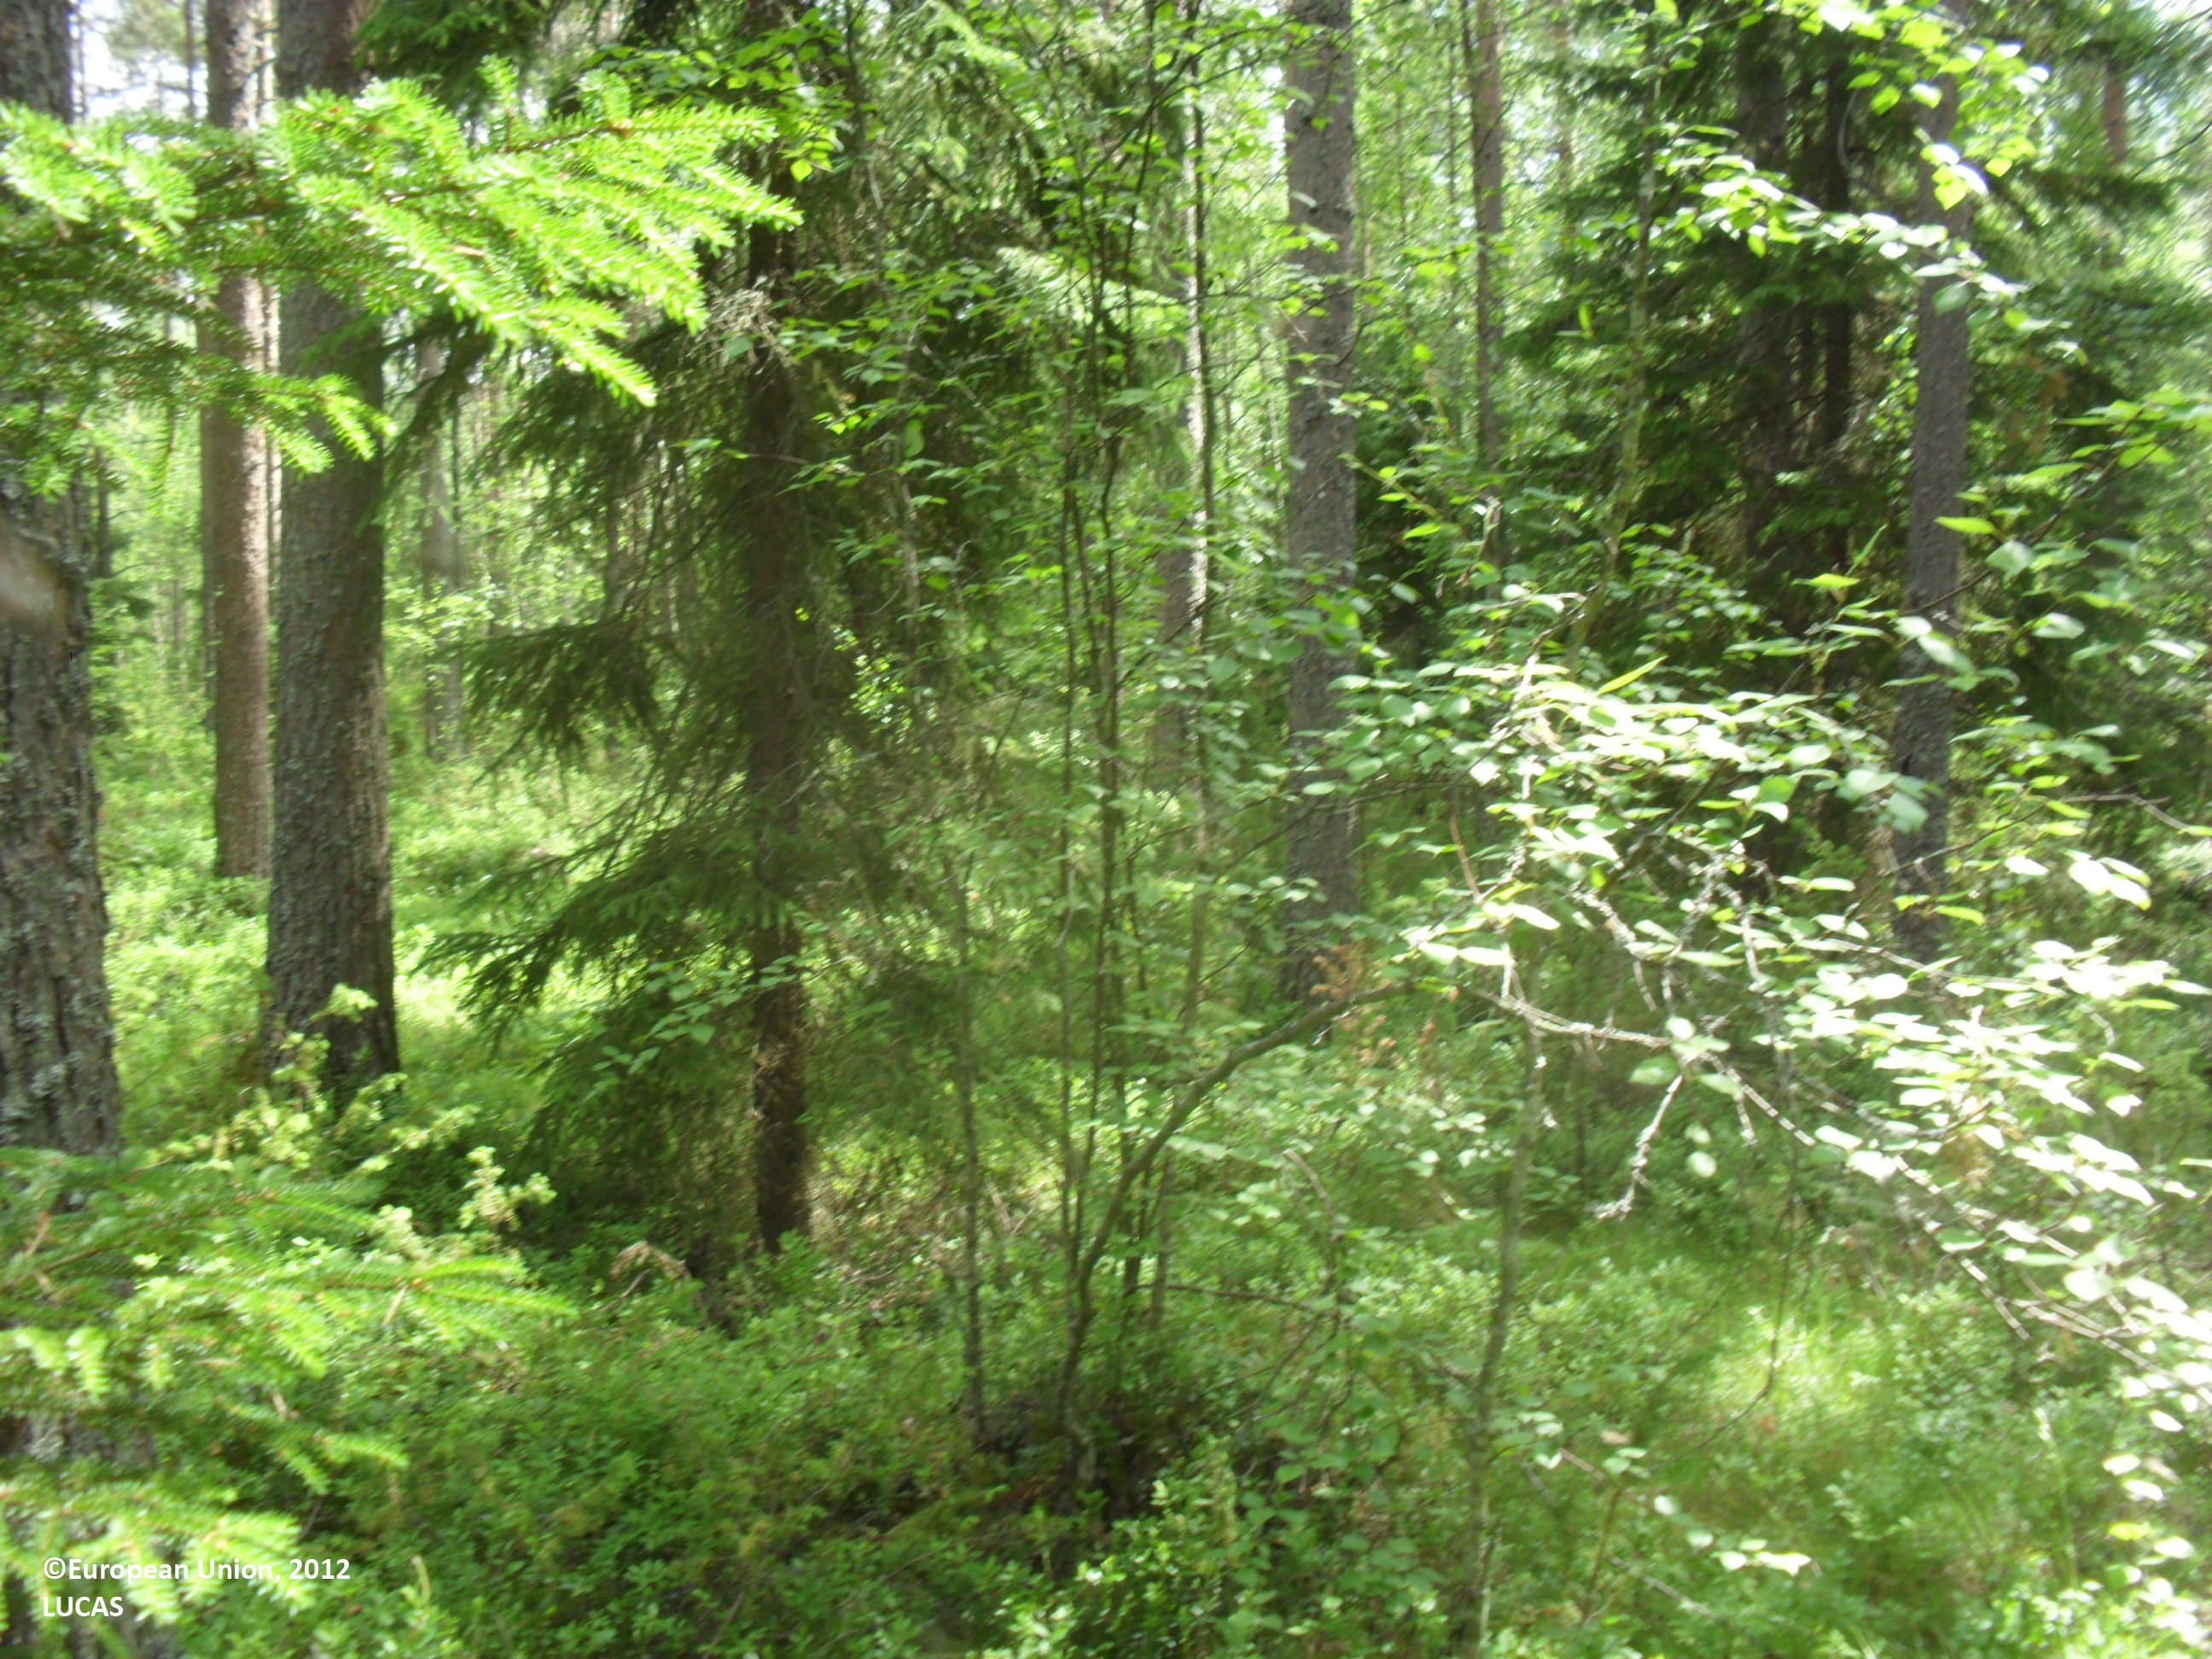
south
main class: Woodland
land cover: Other mixed woodland
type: boreal forest
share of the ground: 50 - 75 %
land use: Forestry
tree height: > 5 m
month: July
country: FI
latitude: 63.5689
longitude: 24.0248
